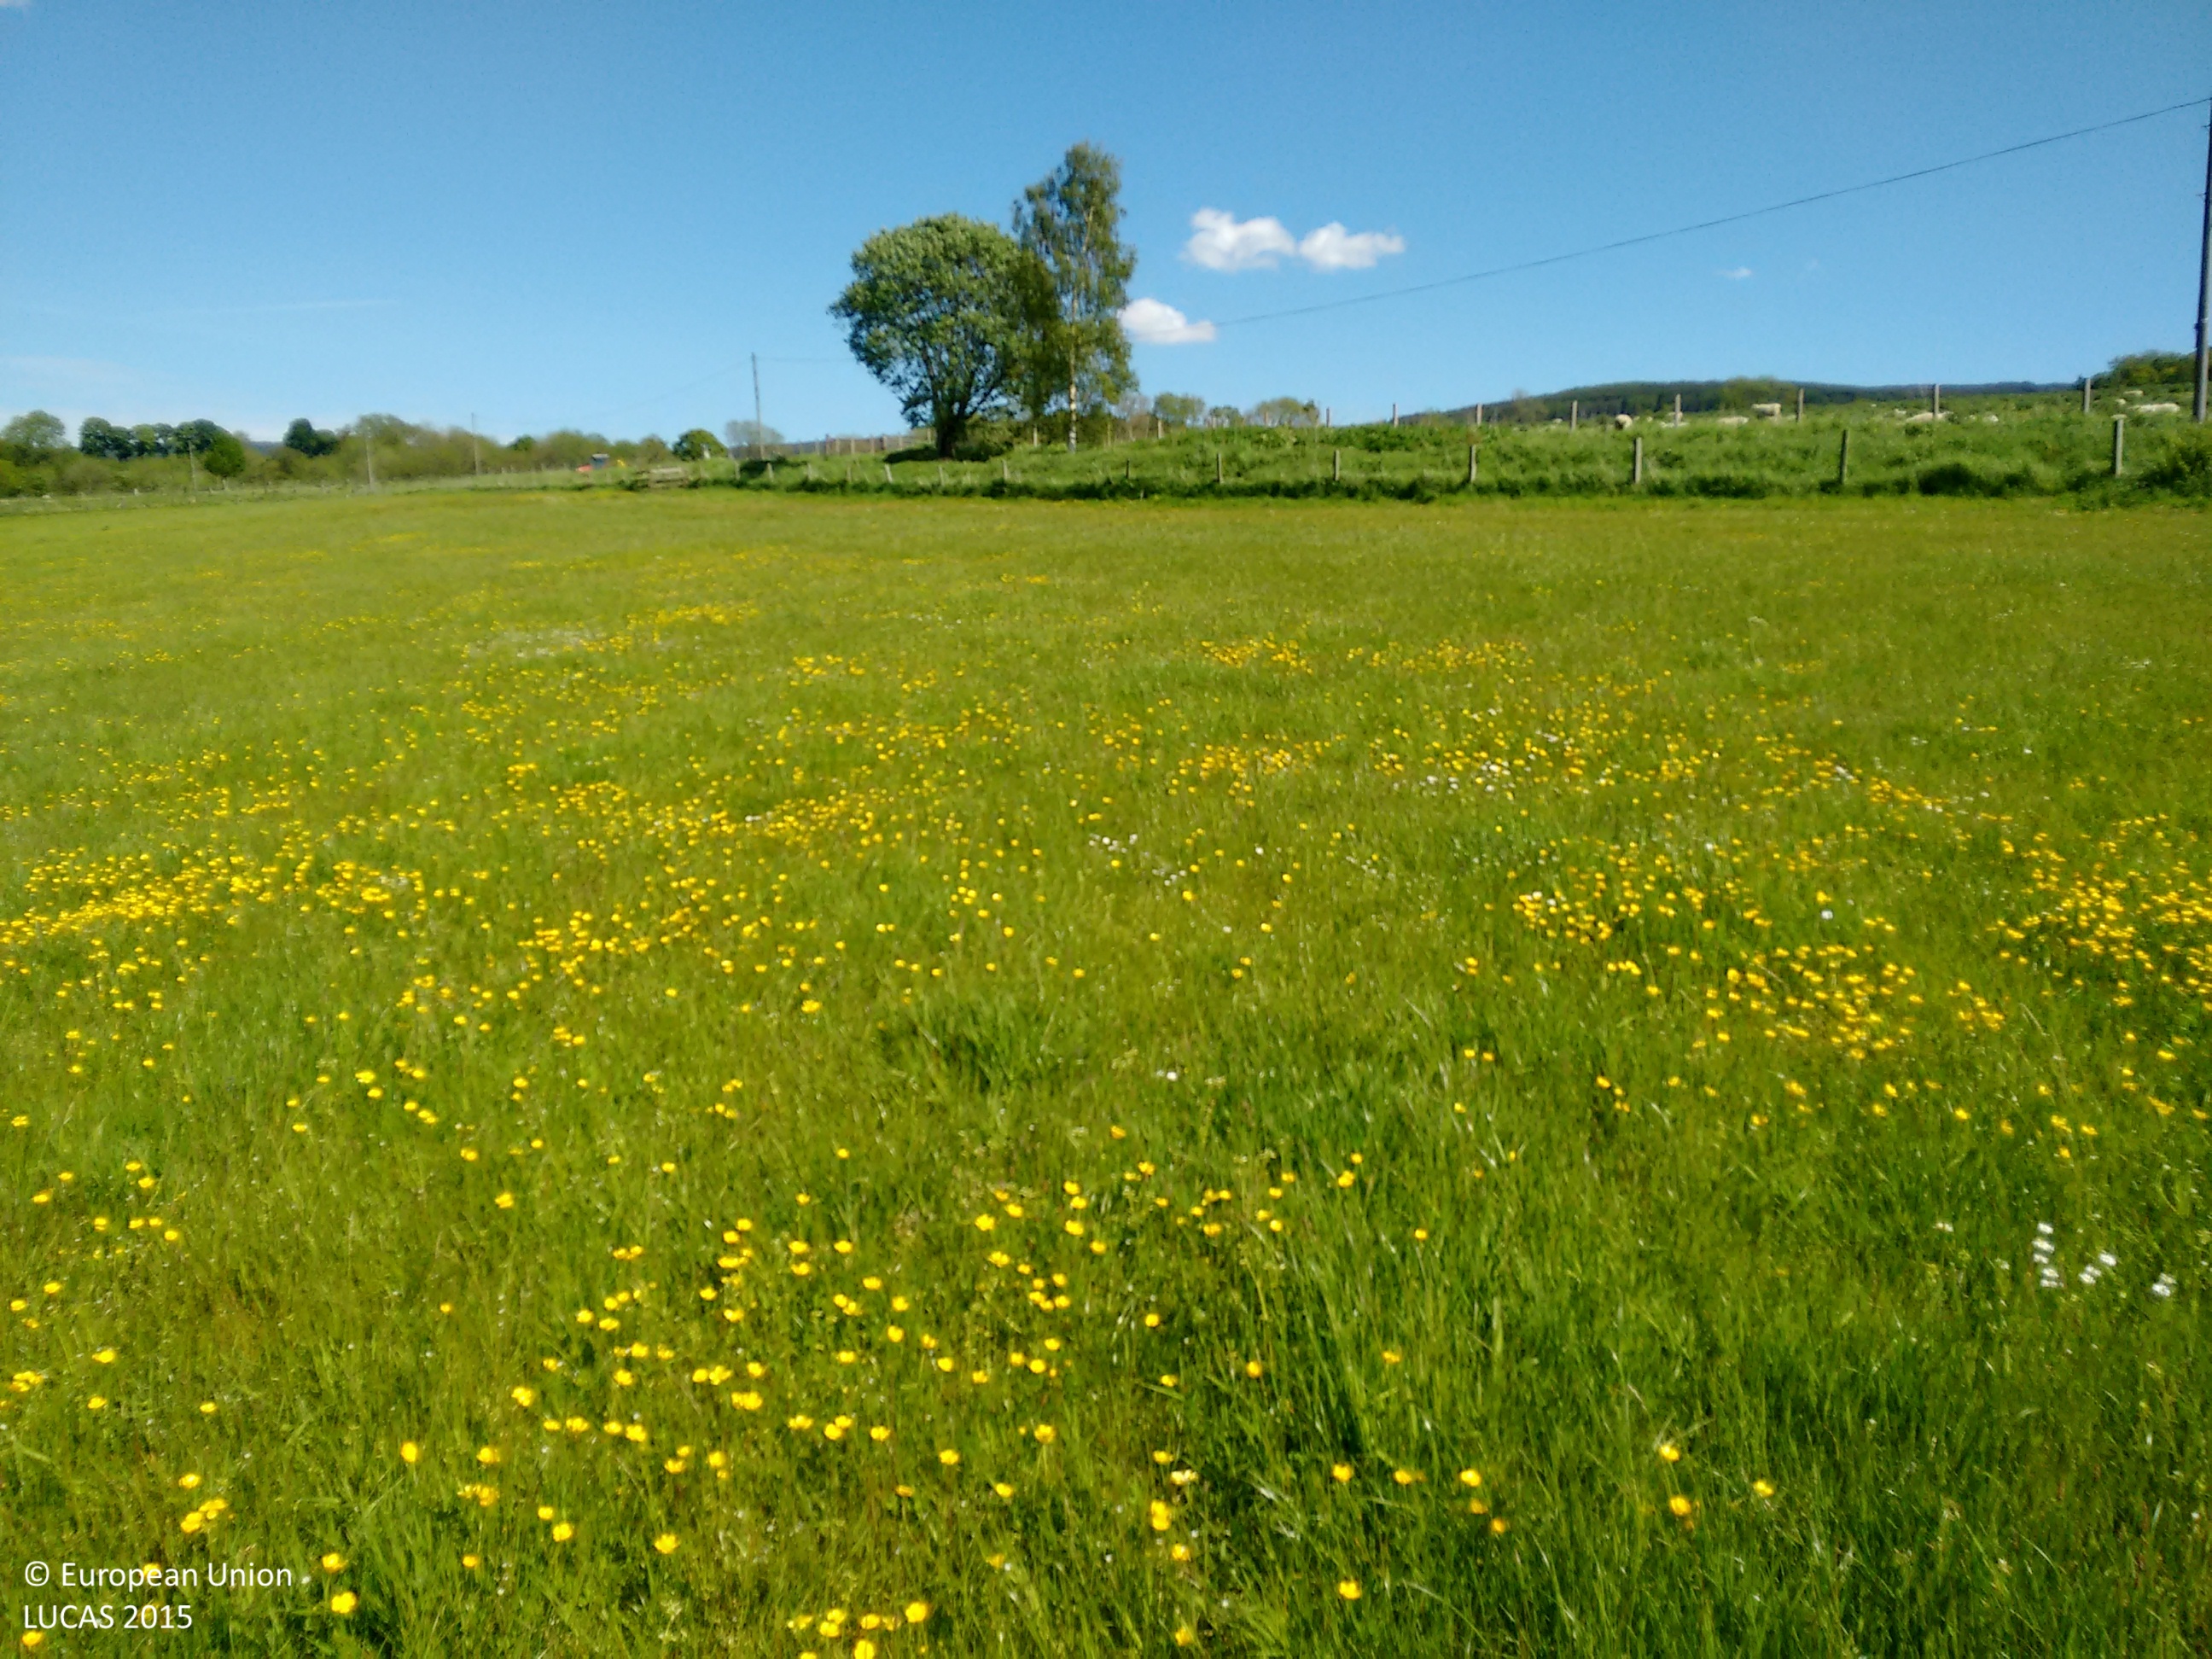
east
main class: Grassland
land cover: Grassland without tree/shrub cover
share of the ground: > 75 %
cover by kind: herbaceous plants 100 %
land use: Agriculture (excluding fallow land and kitchen gardens)
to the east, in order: Grassland without tree/shrub cover; Fences; Grass margins; Tracks; Grass margins; Electric lines; Ditches and canals; Grassland without tree/shrub cover; Ditches and canals; Grassland without tree/shrub cover
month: June
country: GB
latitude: 56.6195
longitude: -3.8522
